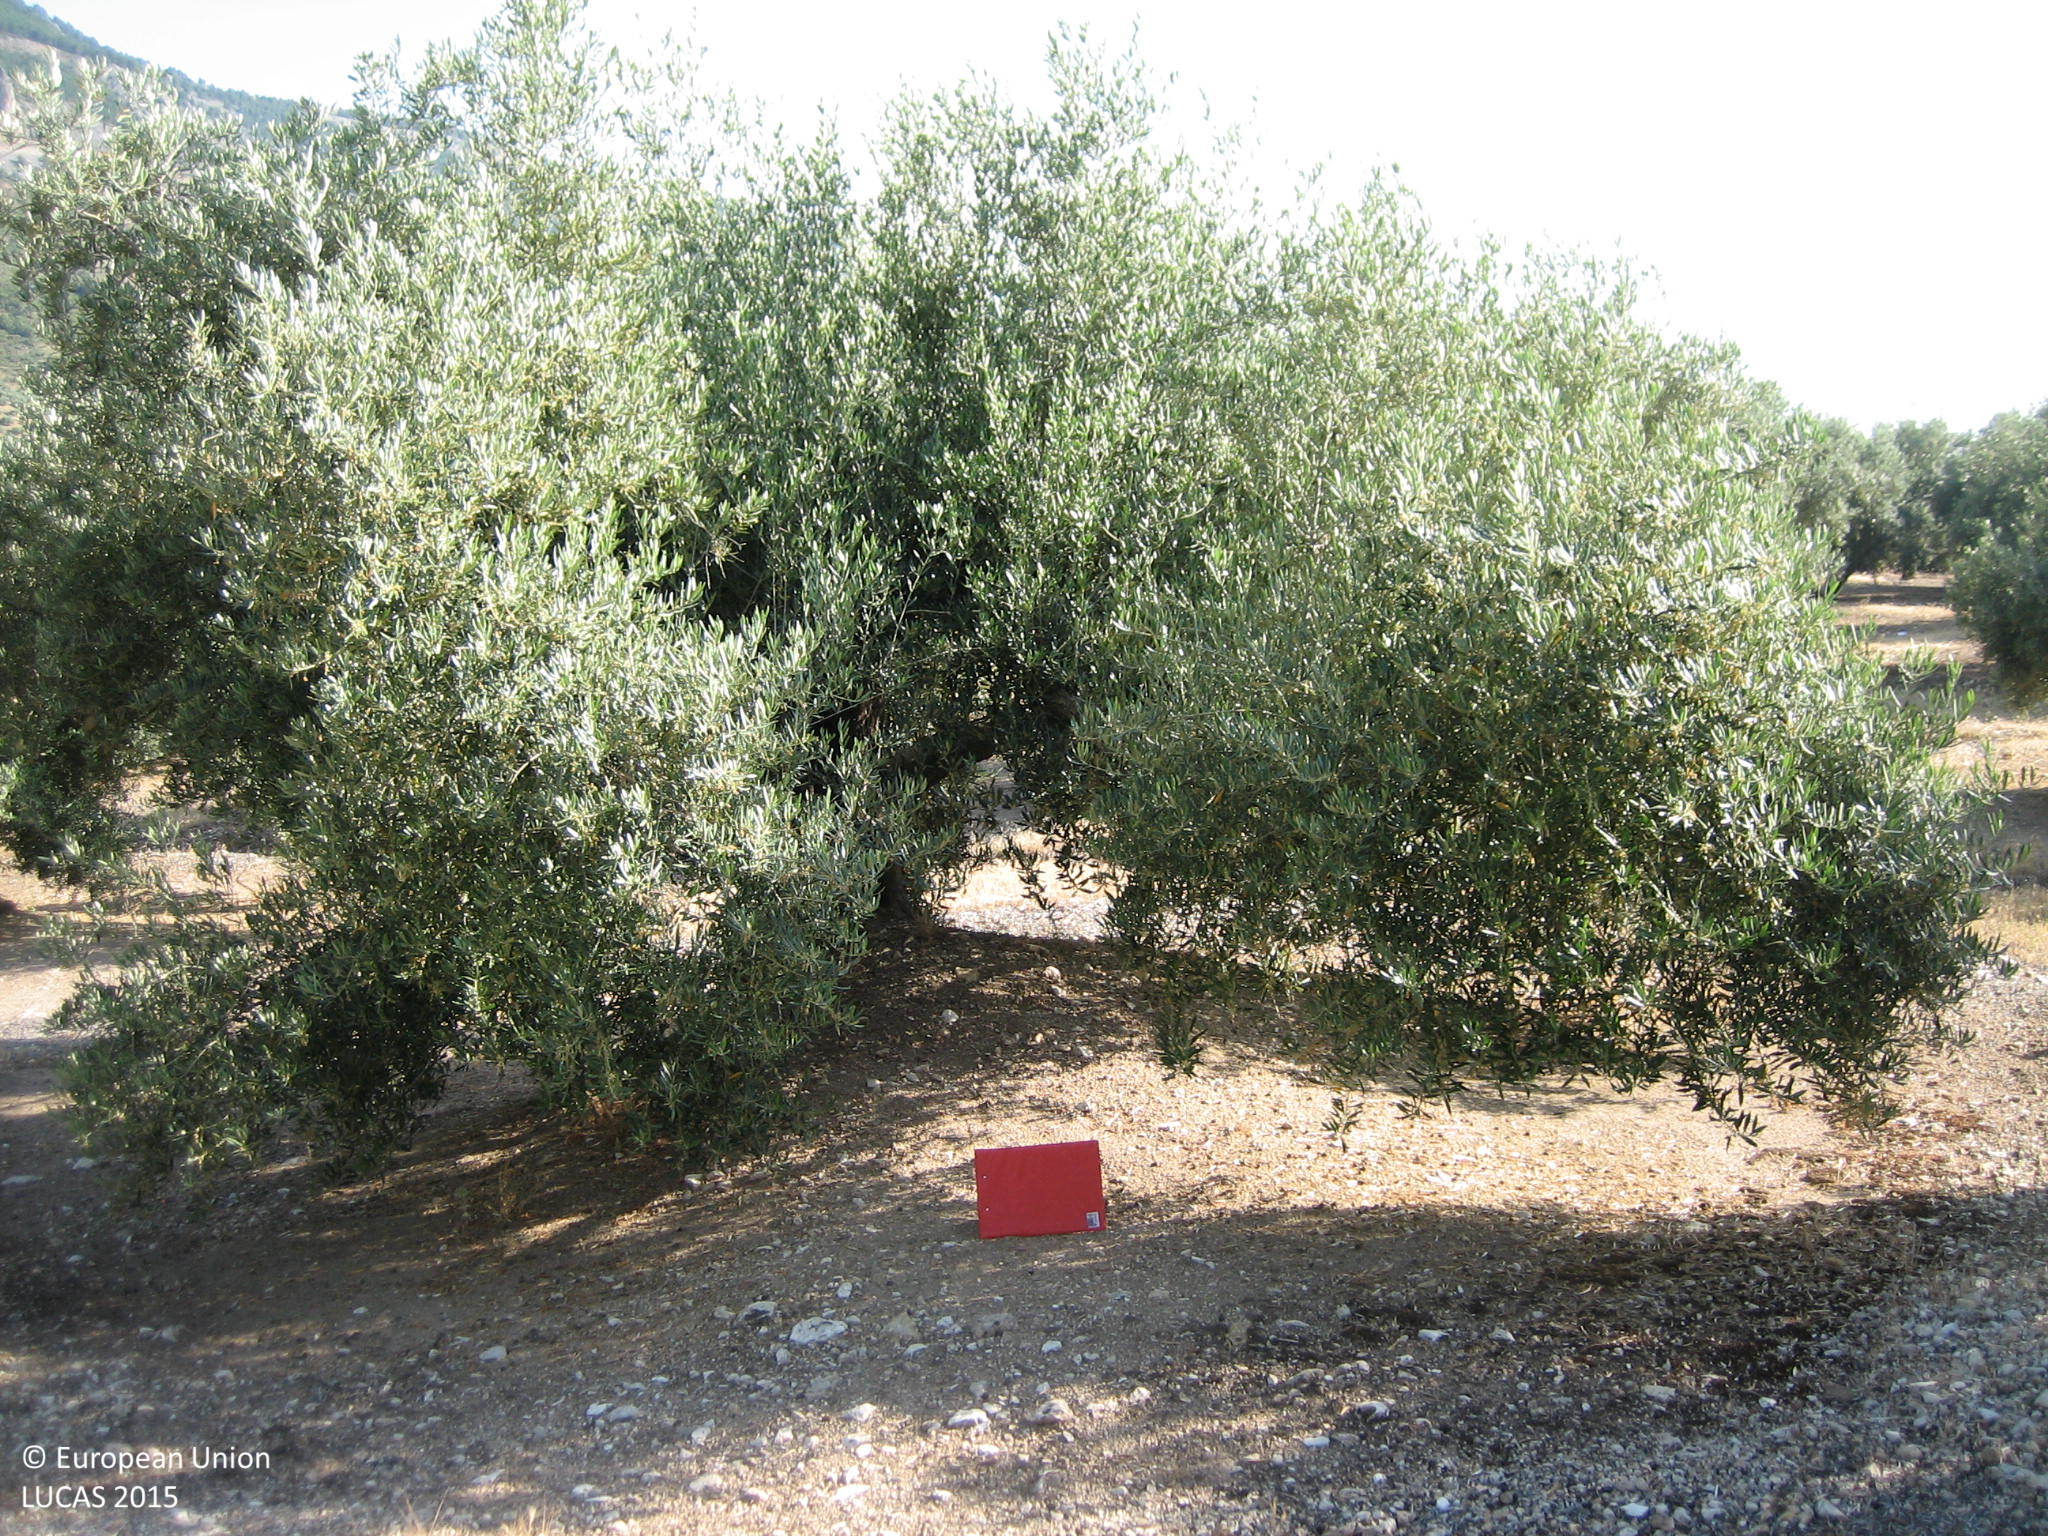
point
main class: Cropland
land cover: Olive groves
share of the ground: 25 - 50 %
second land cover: Spontaneously vegetated surfaces
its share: 10 - 25 %
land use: Agriculture (excluding fallow land and kitchen gardens)
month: June
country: ES
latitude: 37.6197
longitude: -3.7864
